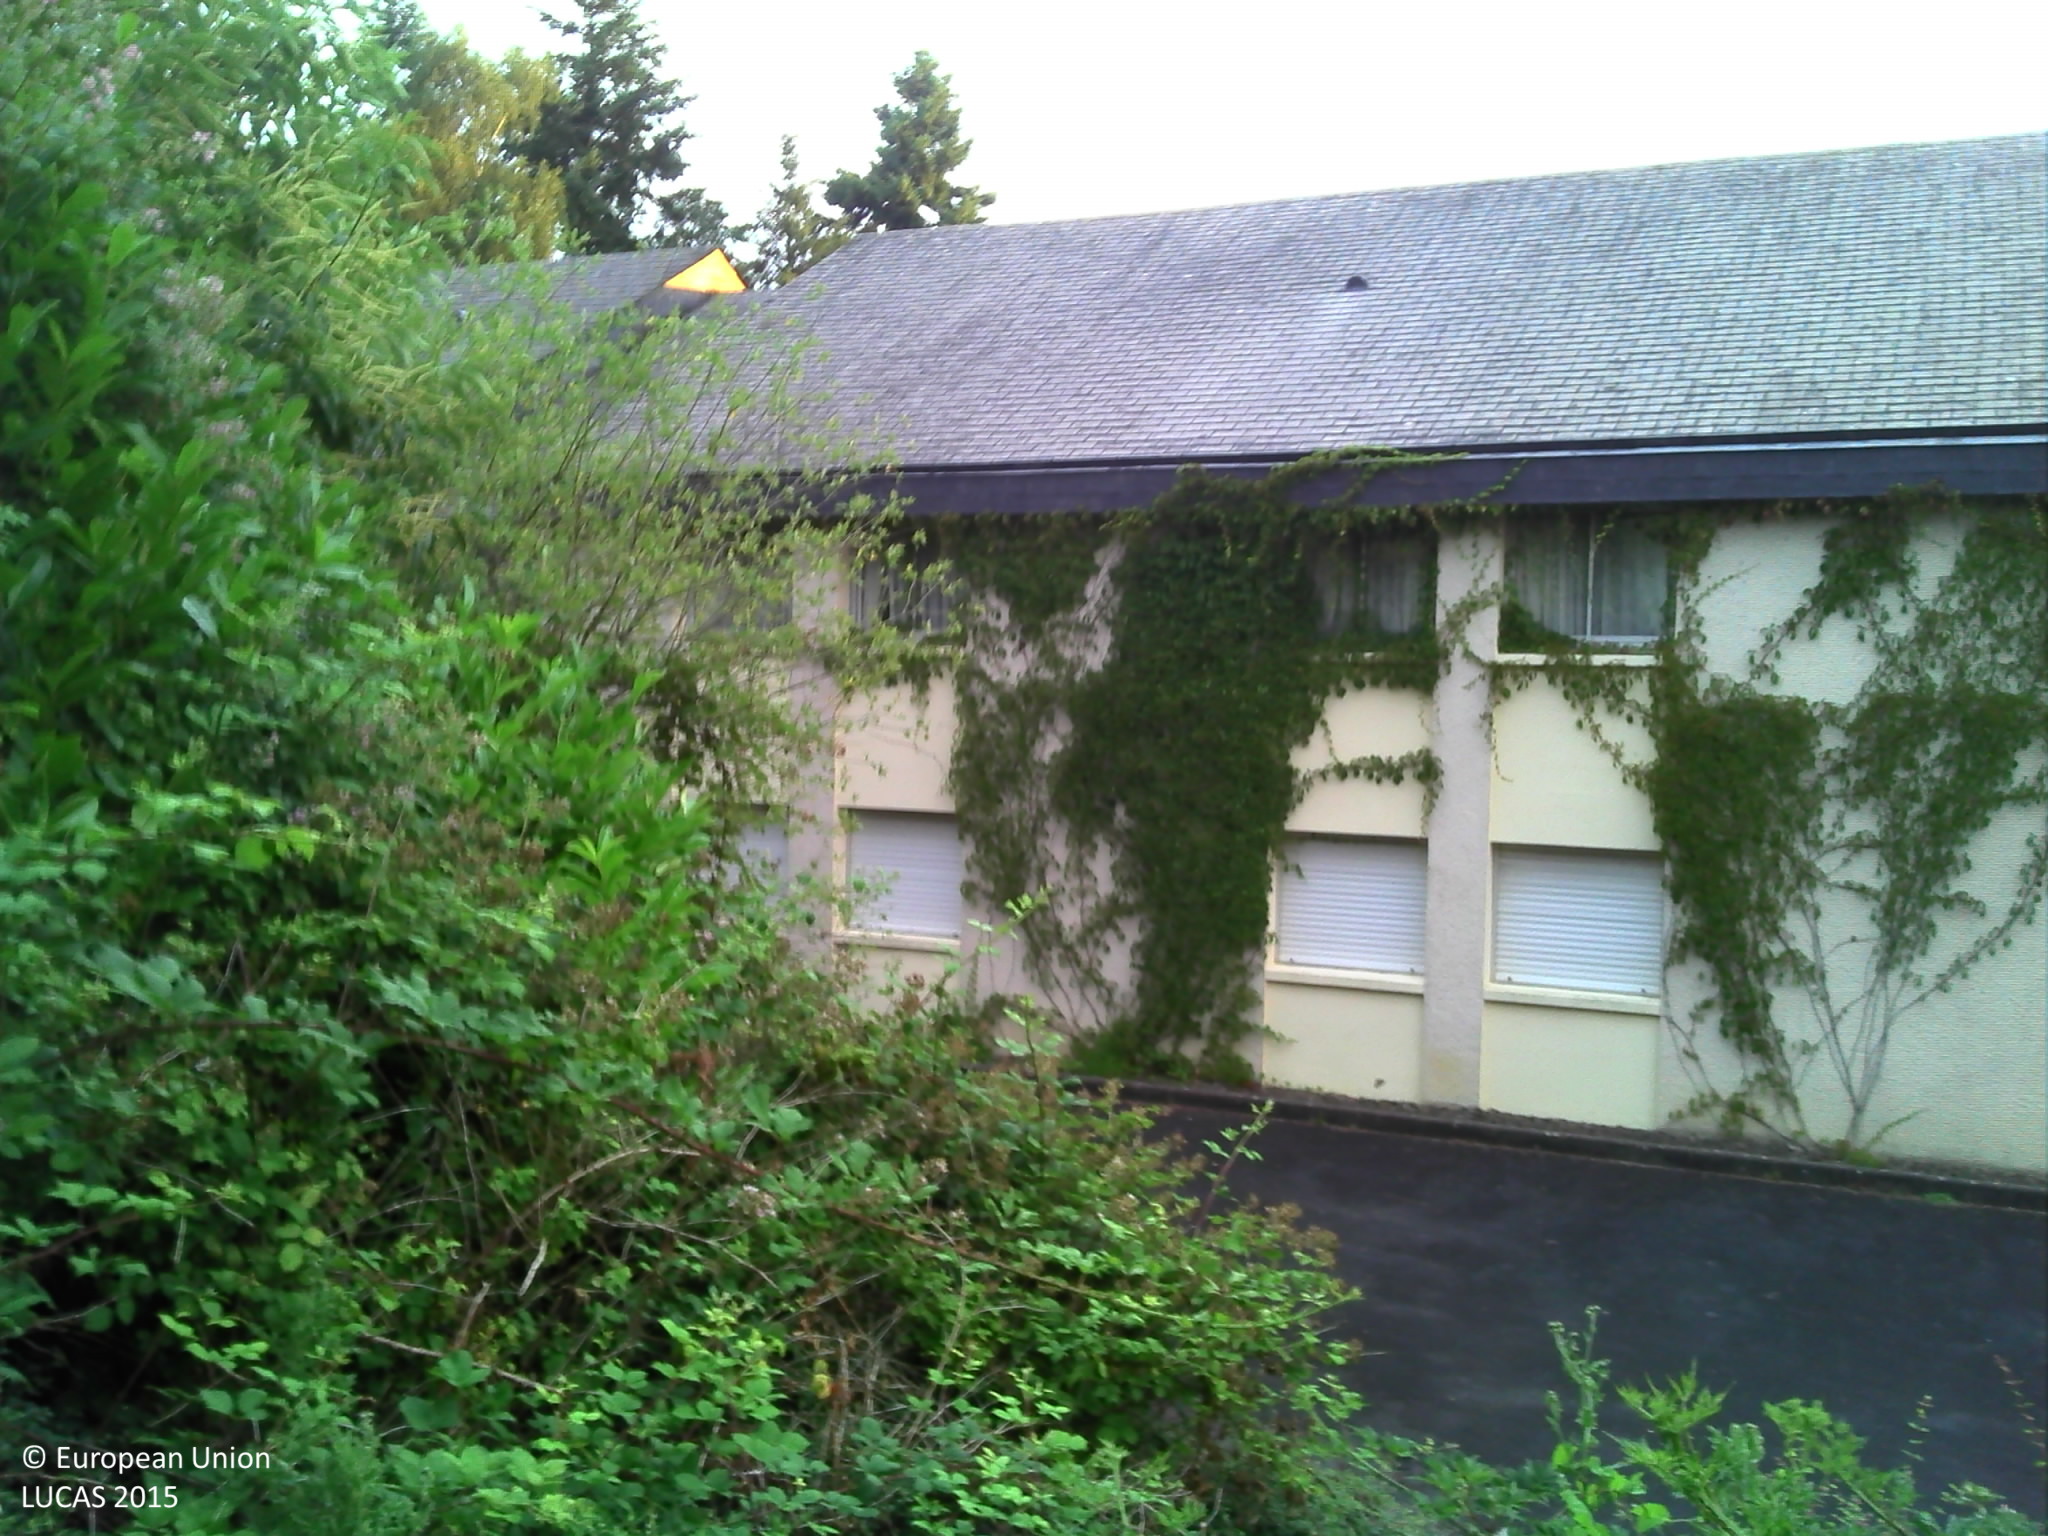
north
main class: Woodland
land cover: Broadleaved woodland
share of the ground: > 75 %
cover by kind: broadleaved forest trees 50 %, shrubs 25 %, herbaceous plants 25 %
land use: Abandoned areas
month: July
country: FR
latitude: 48.3438
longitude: -1.1734
